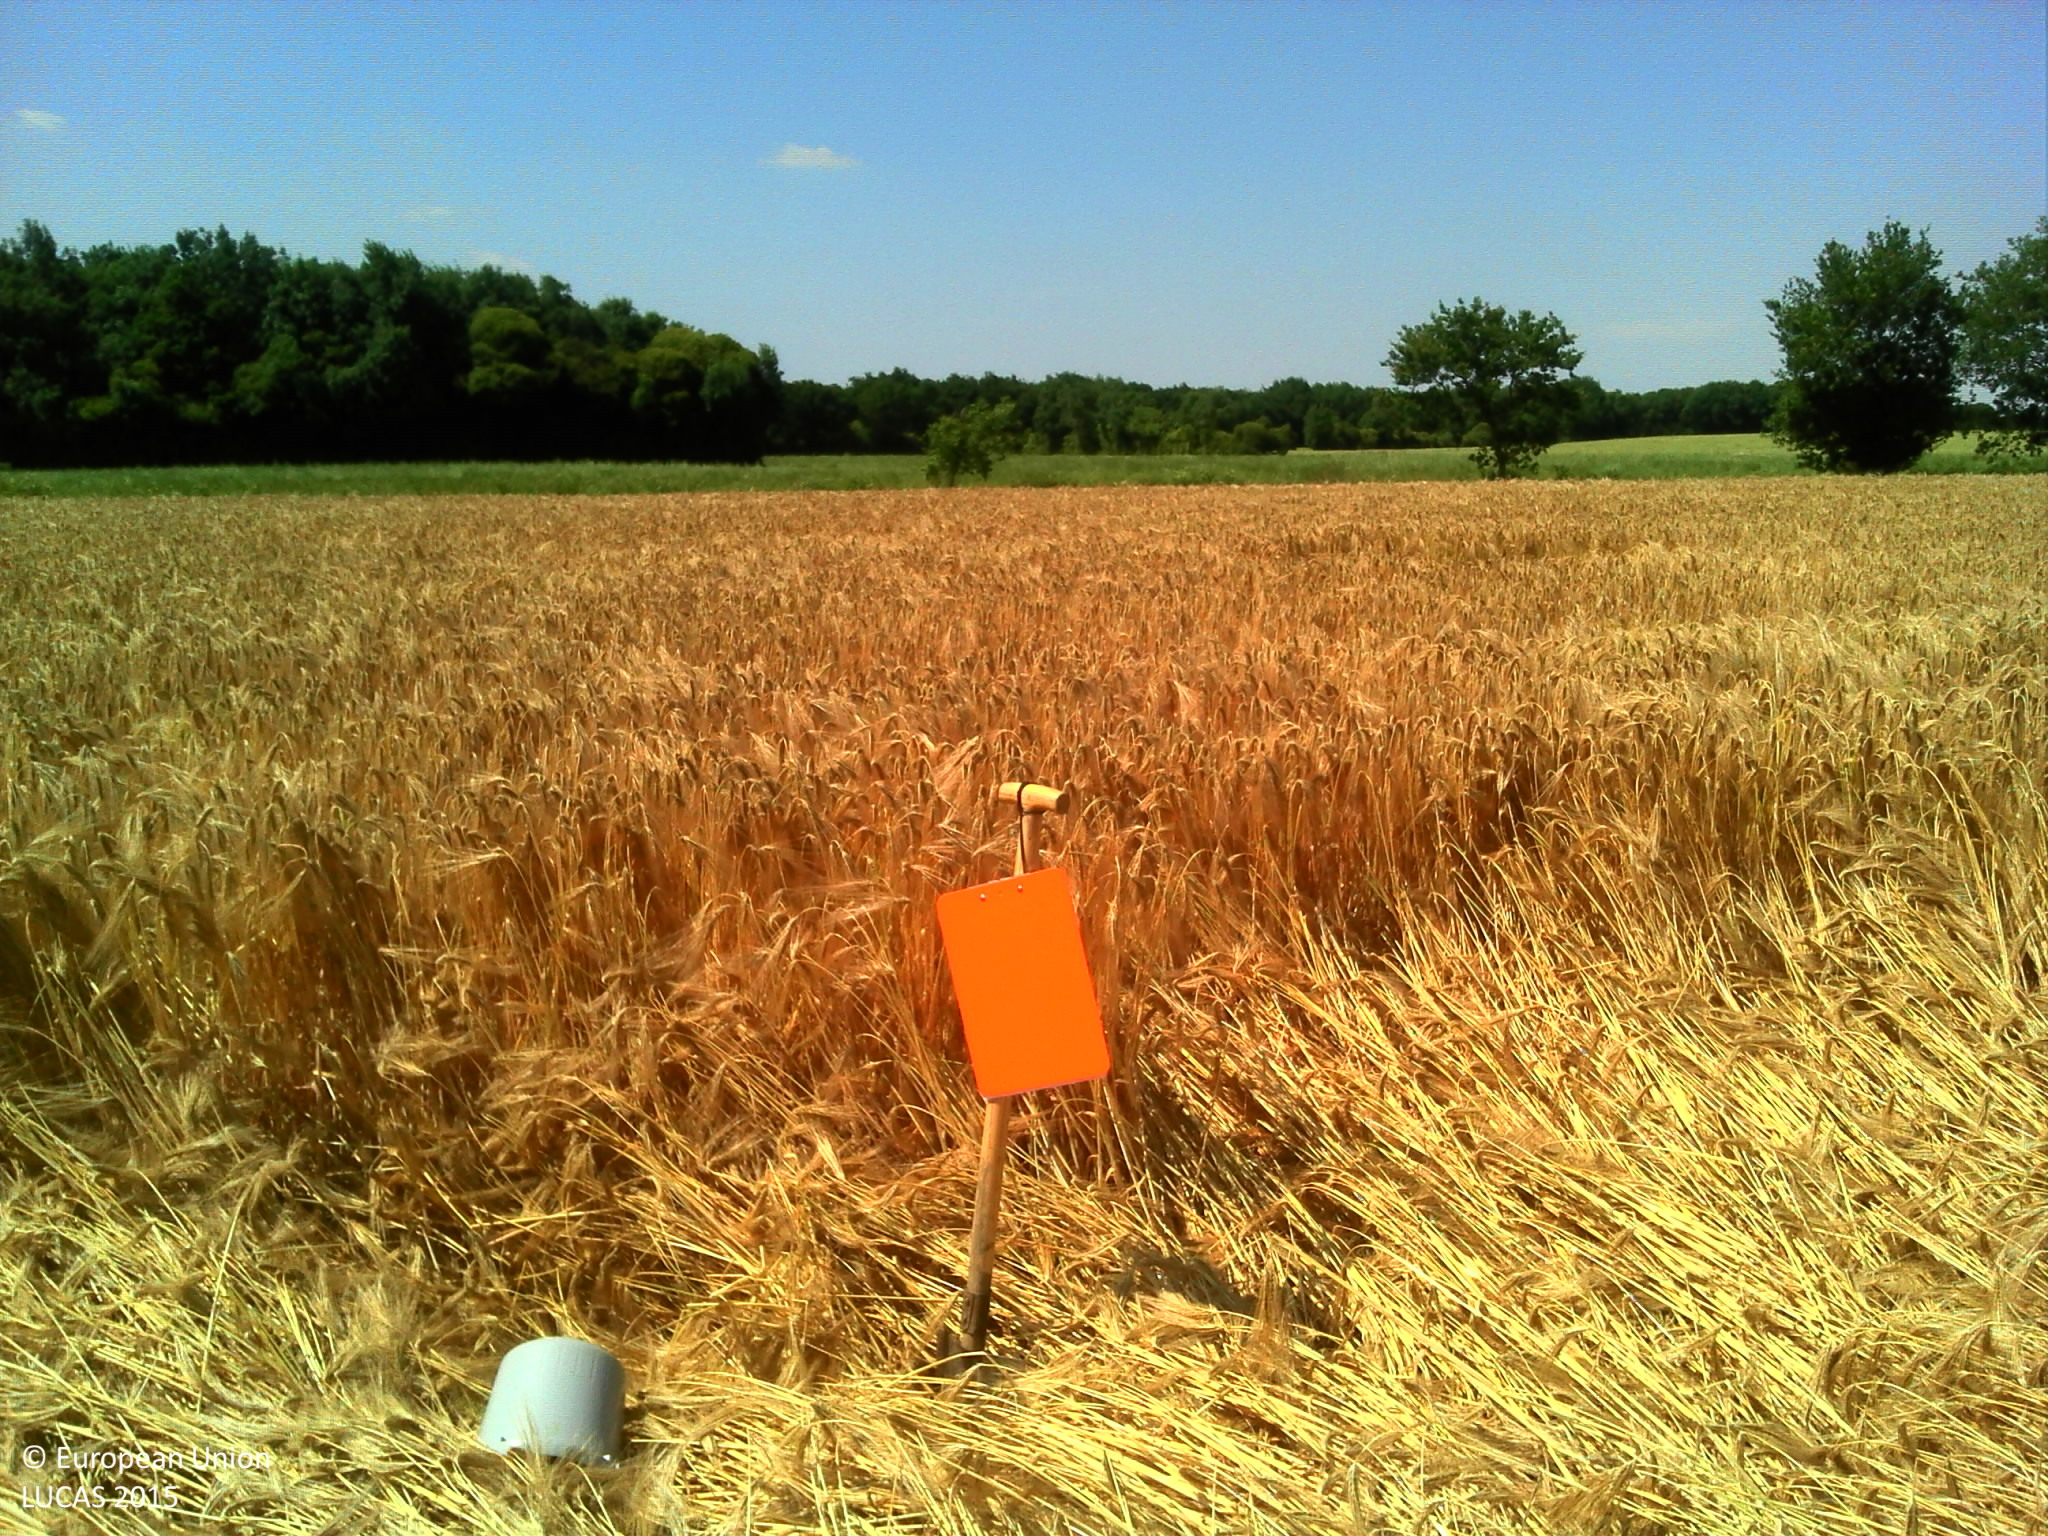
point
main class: Cropland
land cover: Barley
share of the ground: > 75 %
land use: Agriculture (excluding fallow land and kitchen gardens)
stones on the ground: < 10 %
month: June
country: FR
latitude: 46.8504
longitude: -1.3823
